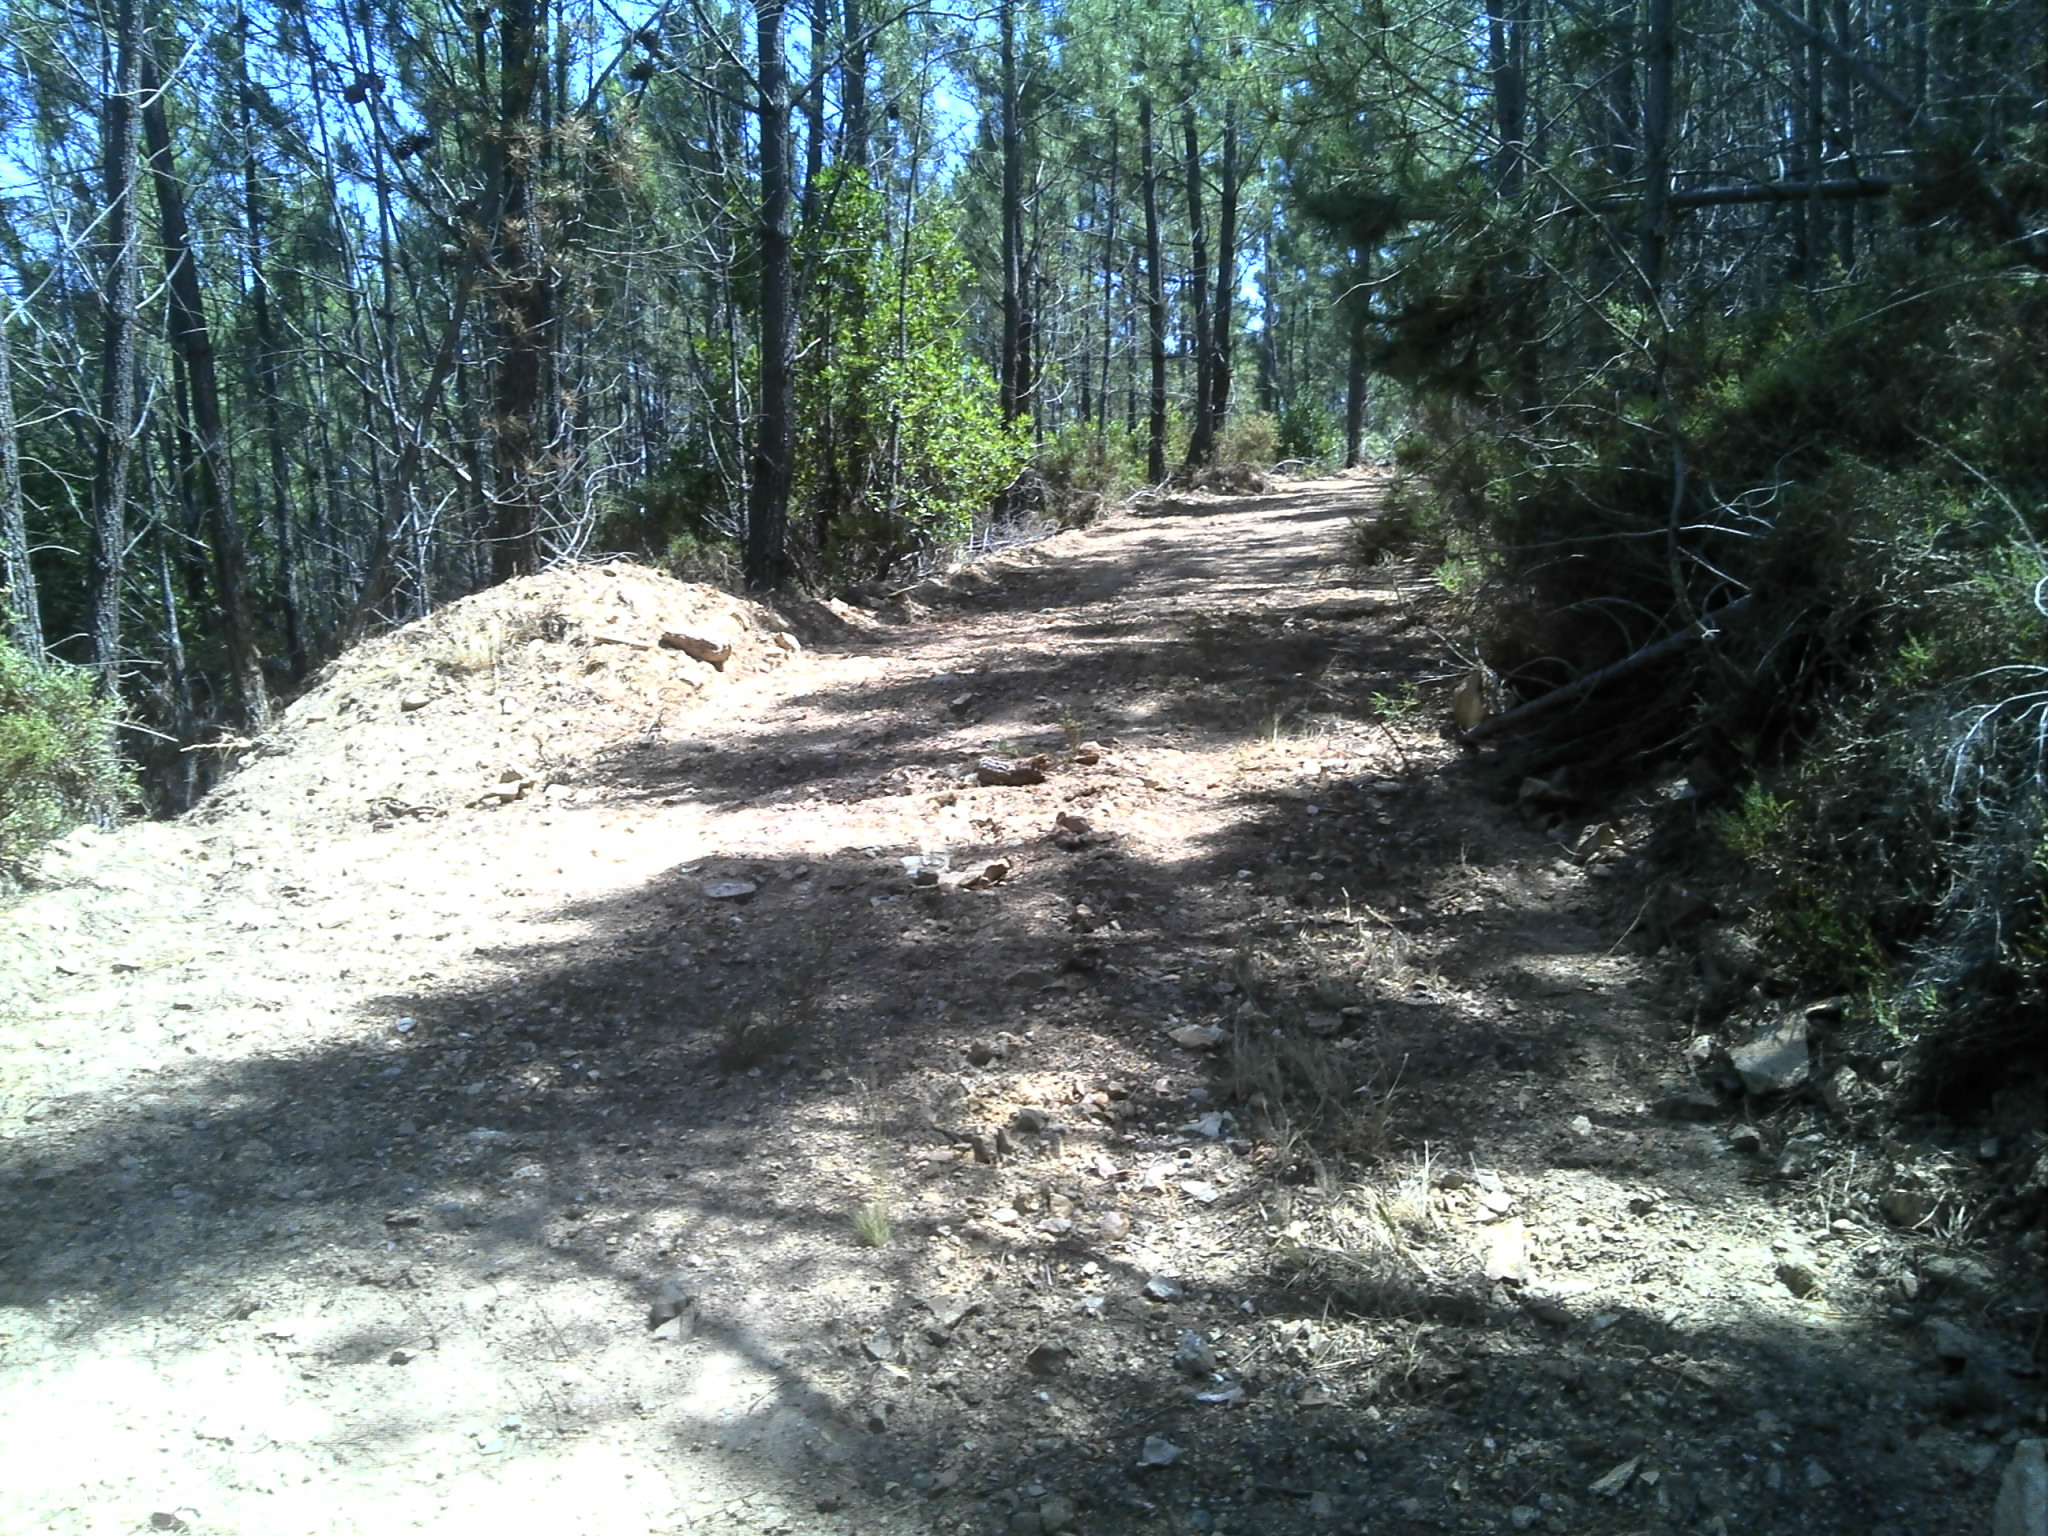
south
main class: Woodland
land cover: Pine dominated coniferous woodland
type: coniferous forest of the mediterranean region
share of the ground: 50 - 75 %
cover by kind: coniferous forest trees 75 %, shrubs 20 %
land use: Forestry
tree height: > 5 m
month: July
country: PT
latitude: 39.9287
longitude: -7.7407
